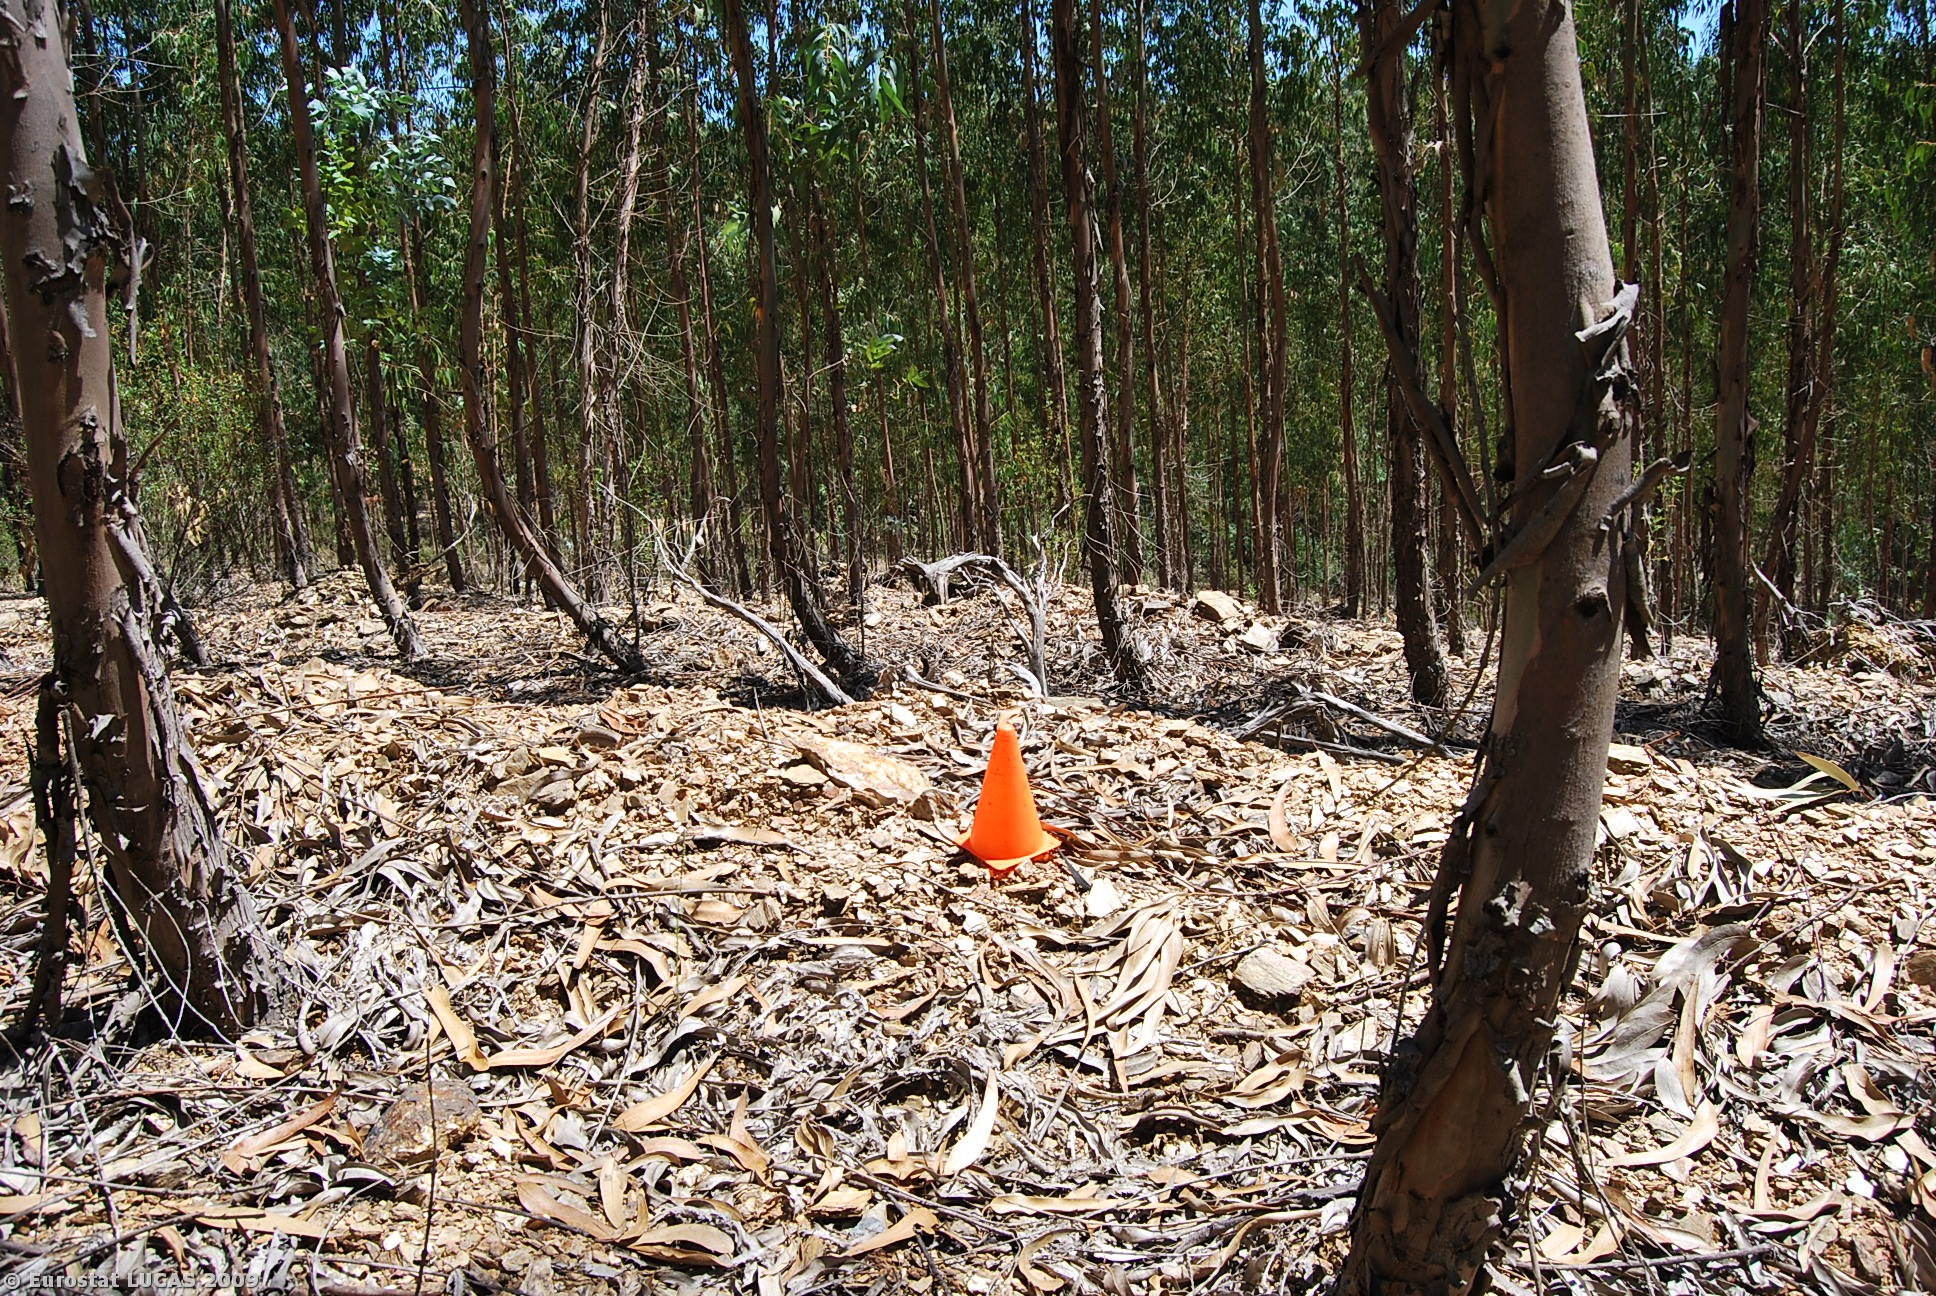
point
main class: Woodland
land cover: Broadleaved woodland
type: plantations and self-sown exotic forest
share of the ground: 50 - 75 %
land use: Forestry
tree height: > 5 m
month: July
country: PT
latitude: 37.6790
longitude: -8.4839
